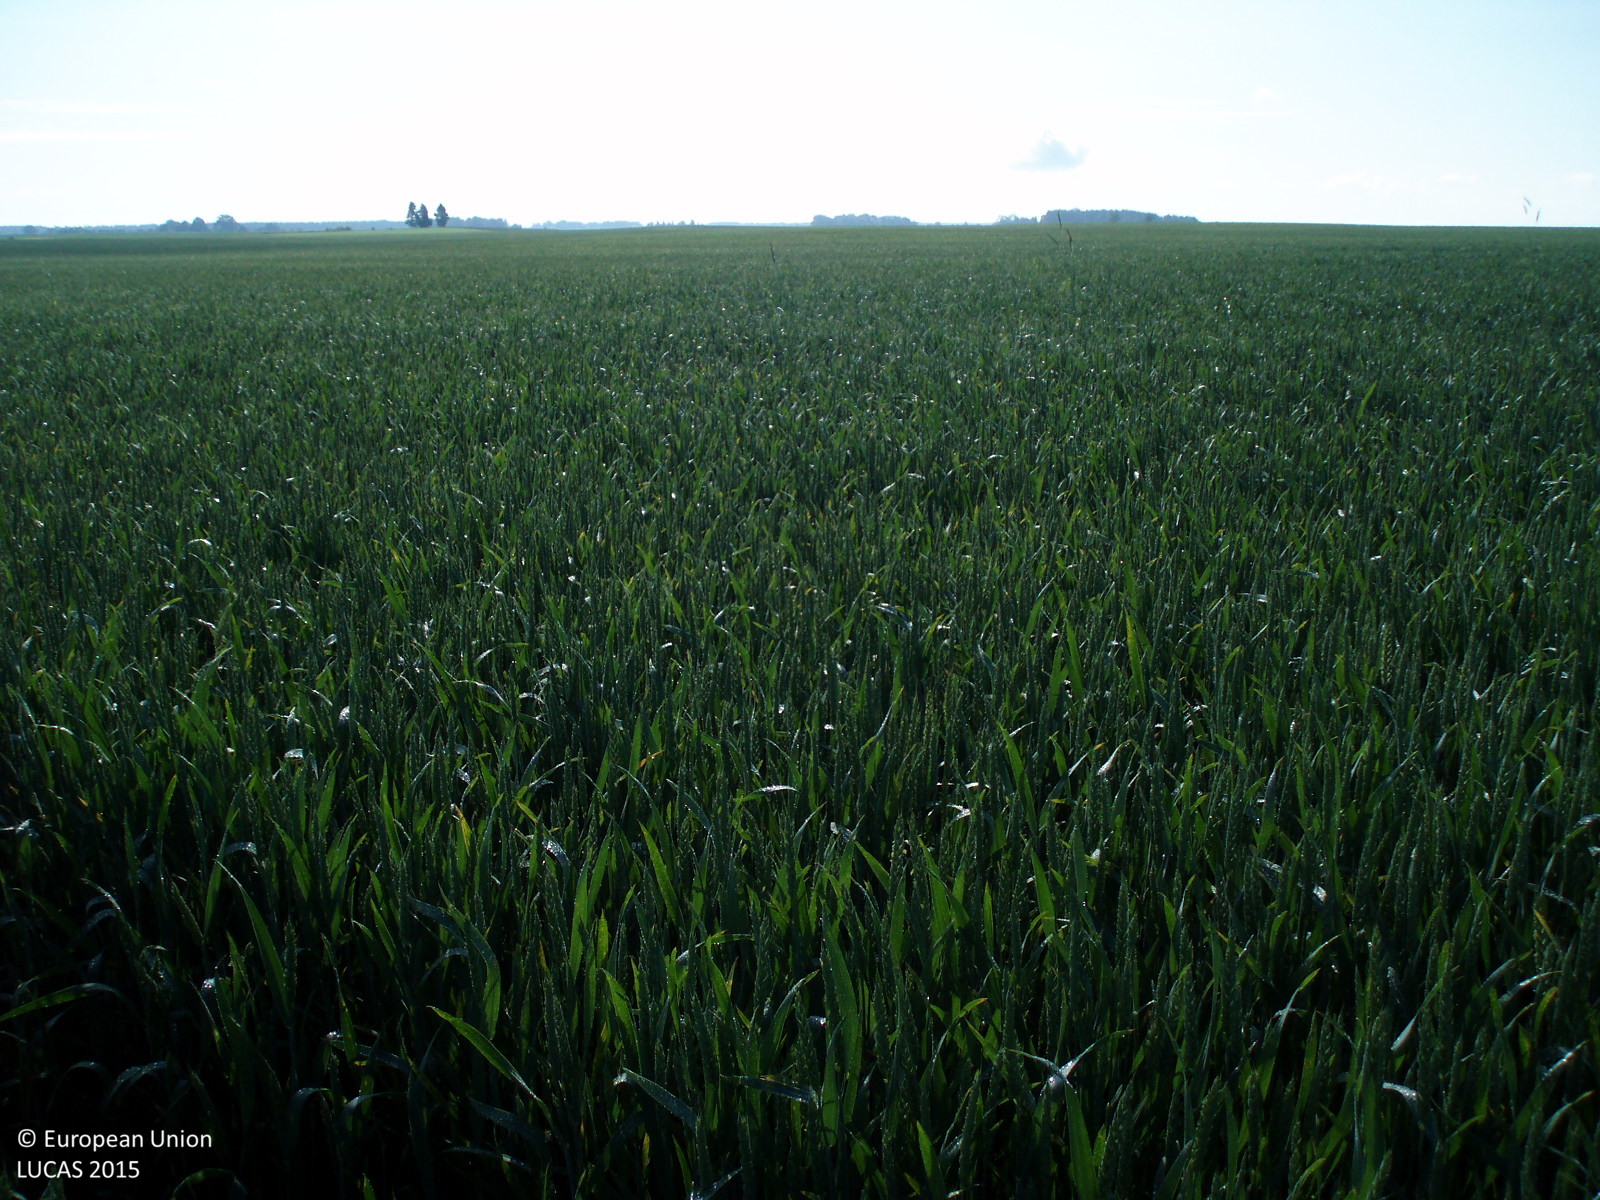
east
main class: Cropland
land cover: Common wheat
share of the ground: > 75 %
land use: Agriculture (excluding fallow land and kitchen gardens)
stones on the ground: < 10 %
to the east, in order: Common wheat
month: June
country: LT
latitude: 56.3467
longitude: 23.3239
